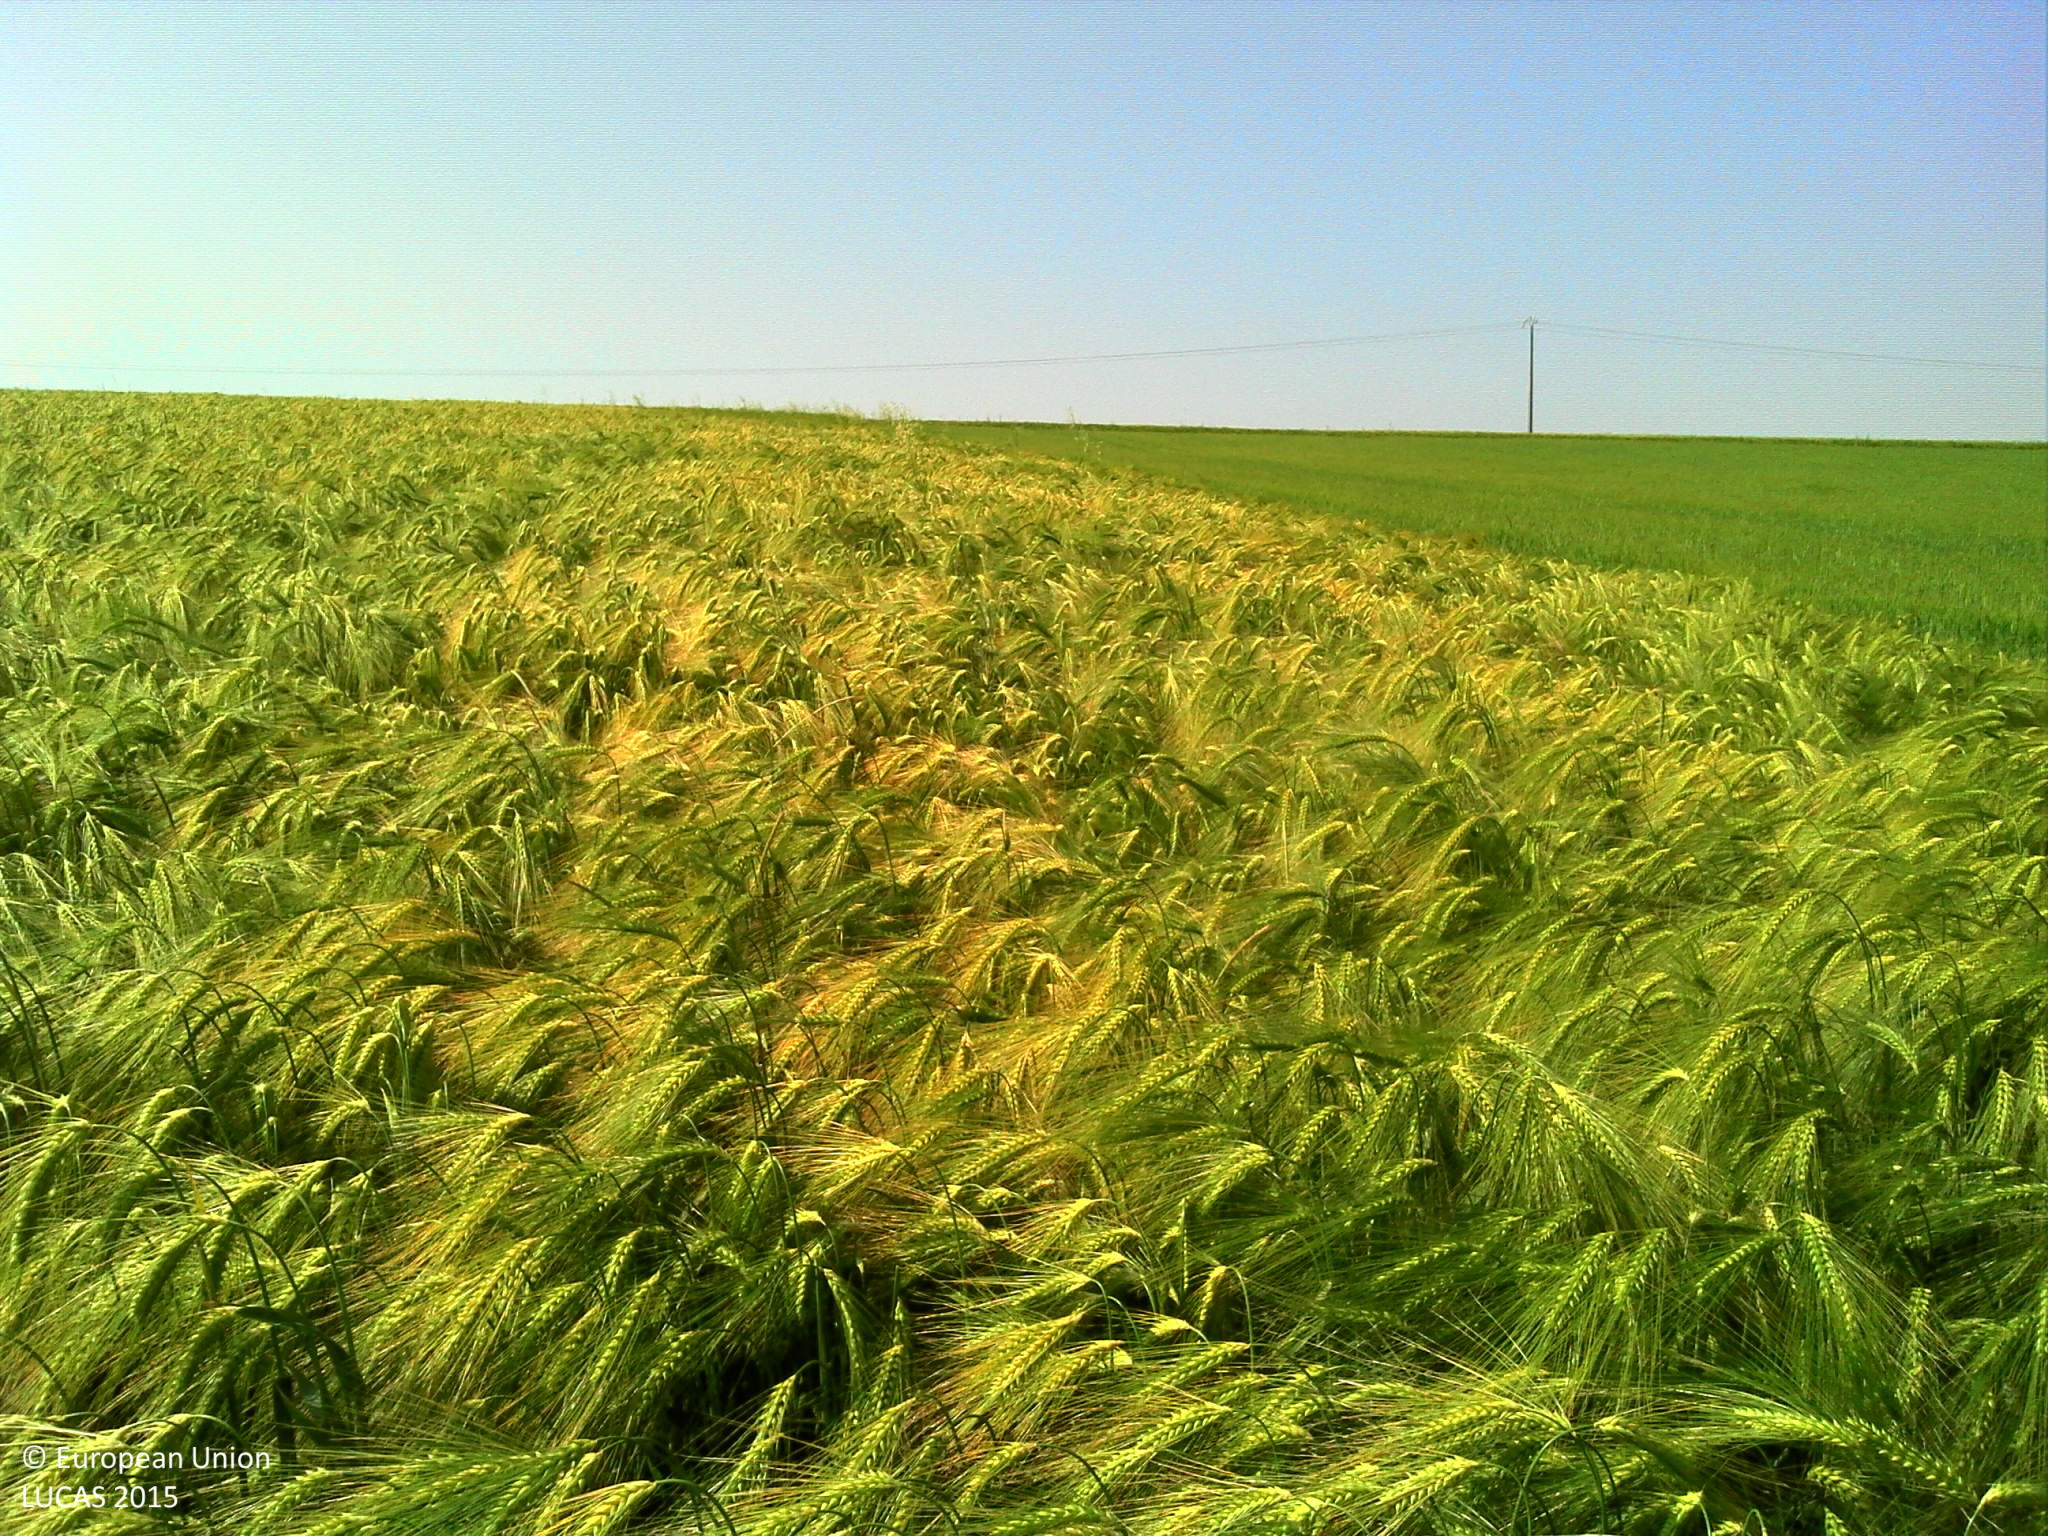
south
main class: Cropland
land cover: Barley
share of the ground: > 75 %
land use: Agriculture (excluding fallow land and kitchen gardens)
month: June
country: FR
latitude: 50.4755
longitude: 2.4484
